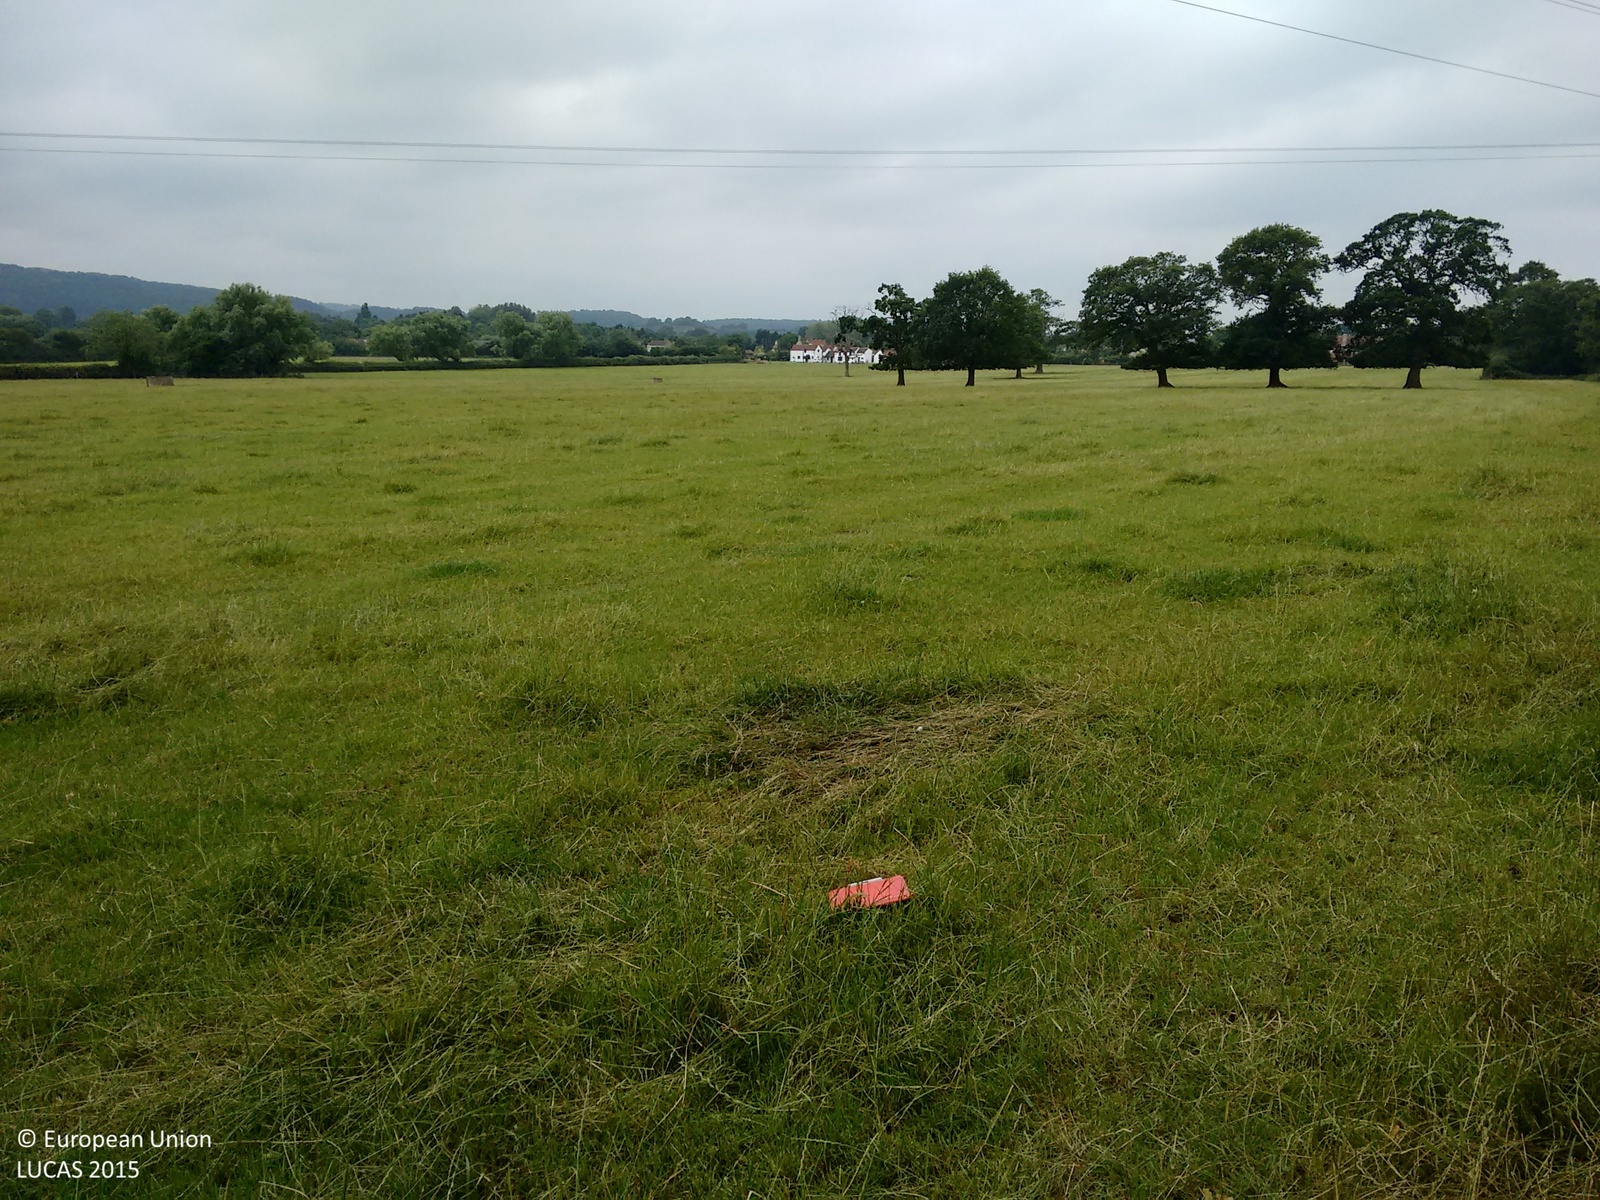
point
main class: Grassland
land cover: Grassland without tree/shrub cover
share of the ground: > 75 %
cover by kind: herbaceous plants 100 %
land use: Agriculture (excluding fallow land and kitchen gardens)
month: July
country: GB
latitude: 51.3553
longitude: -2.7797
